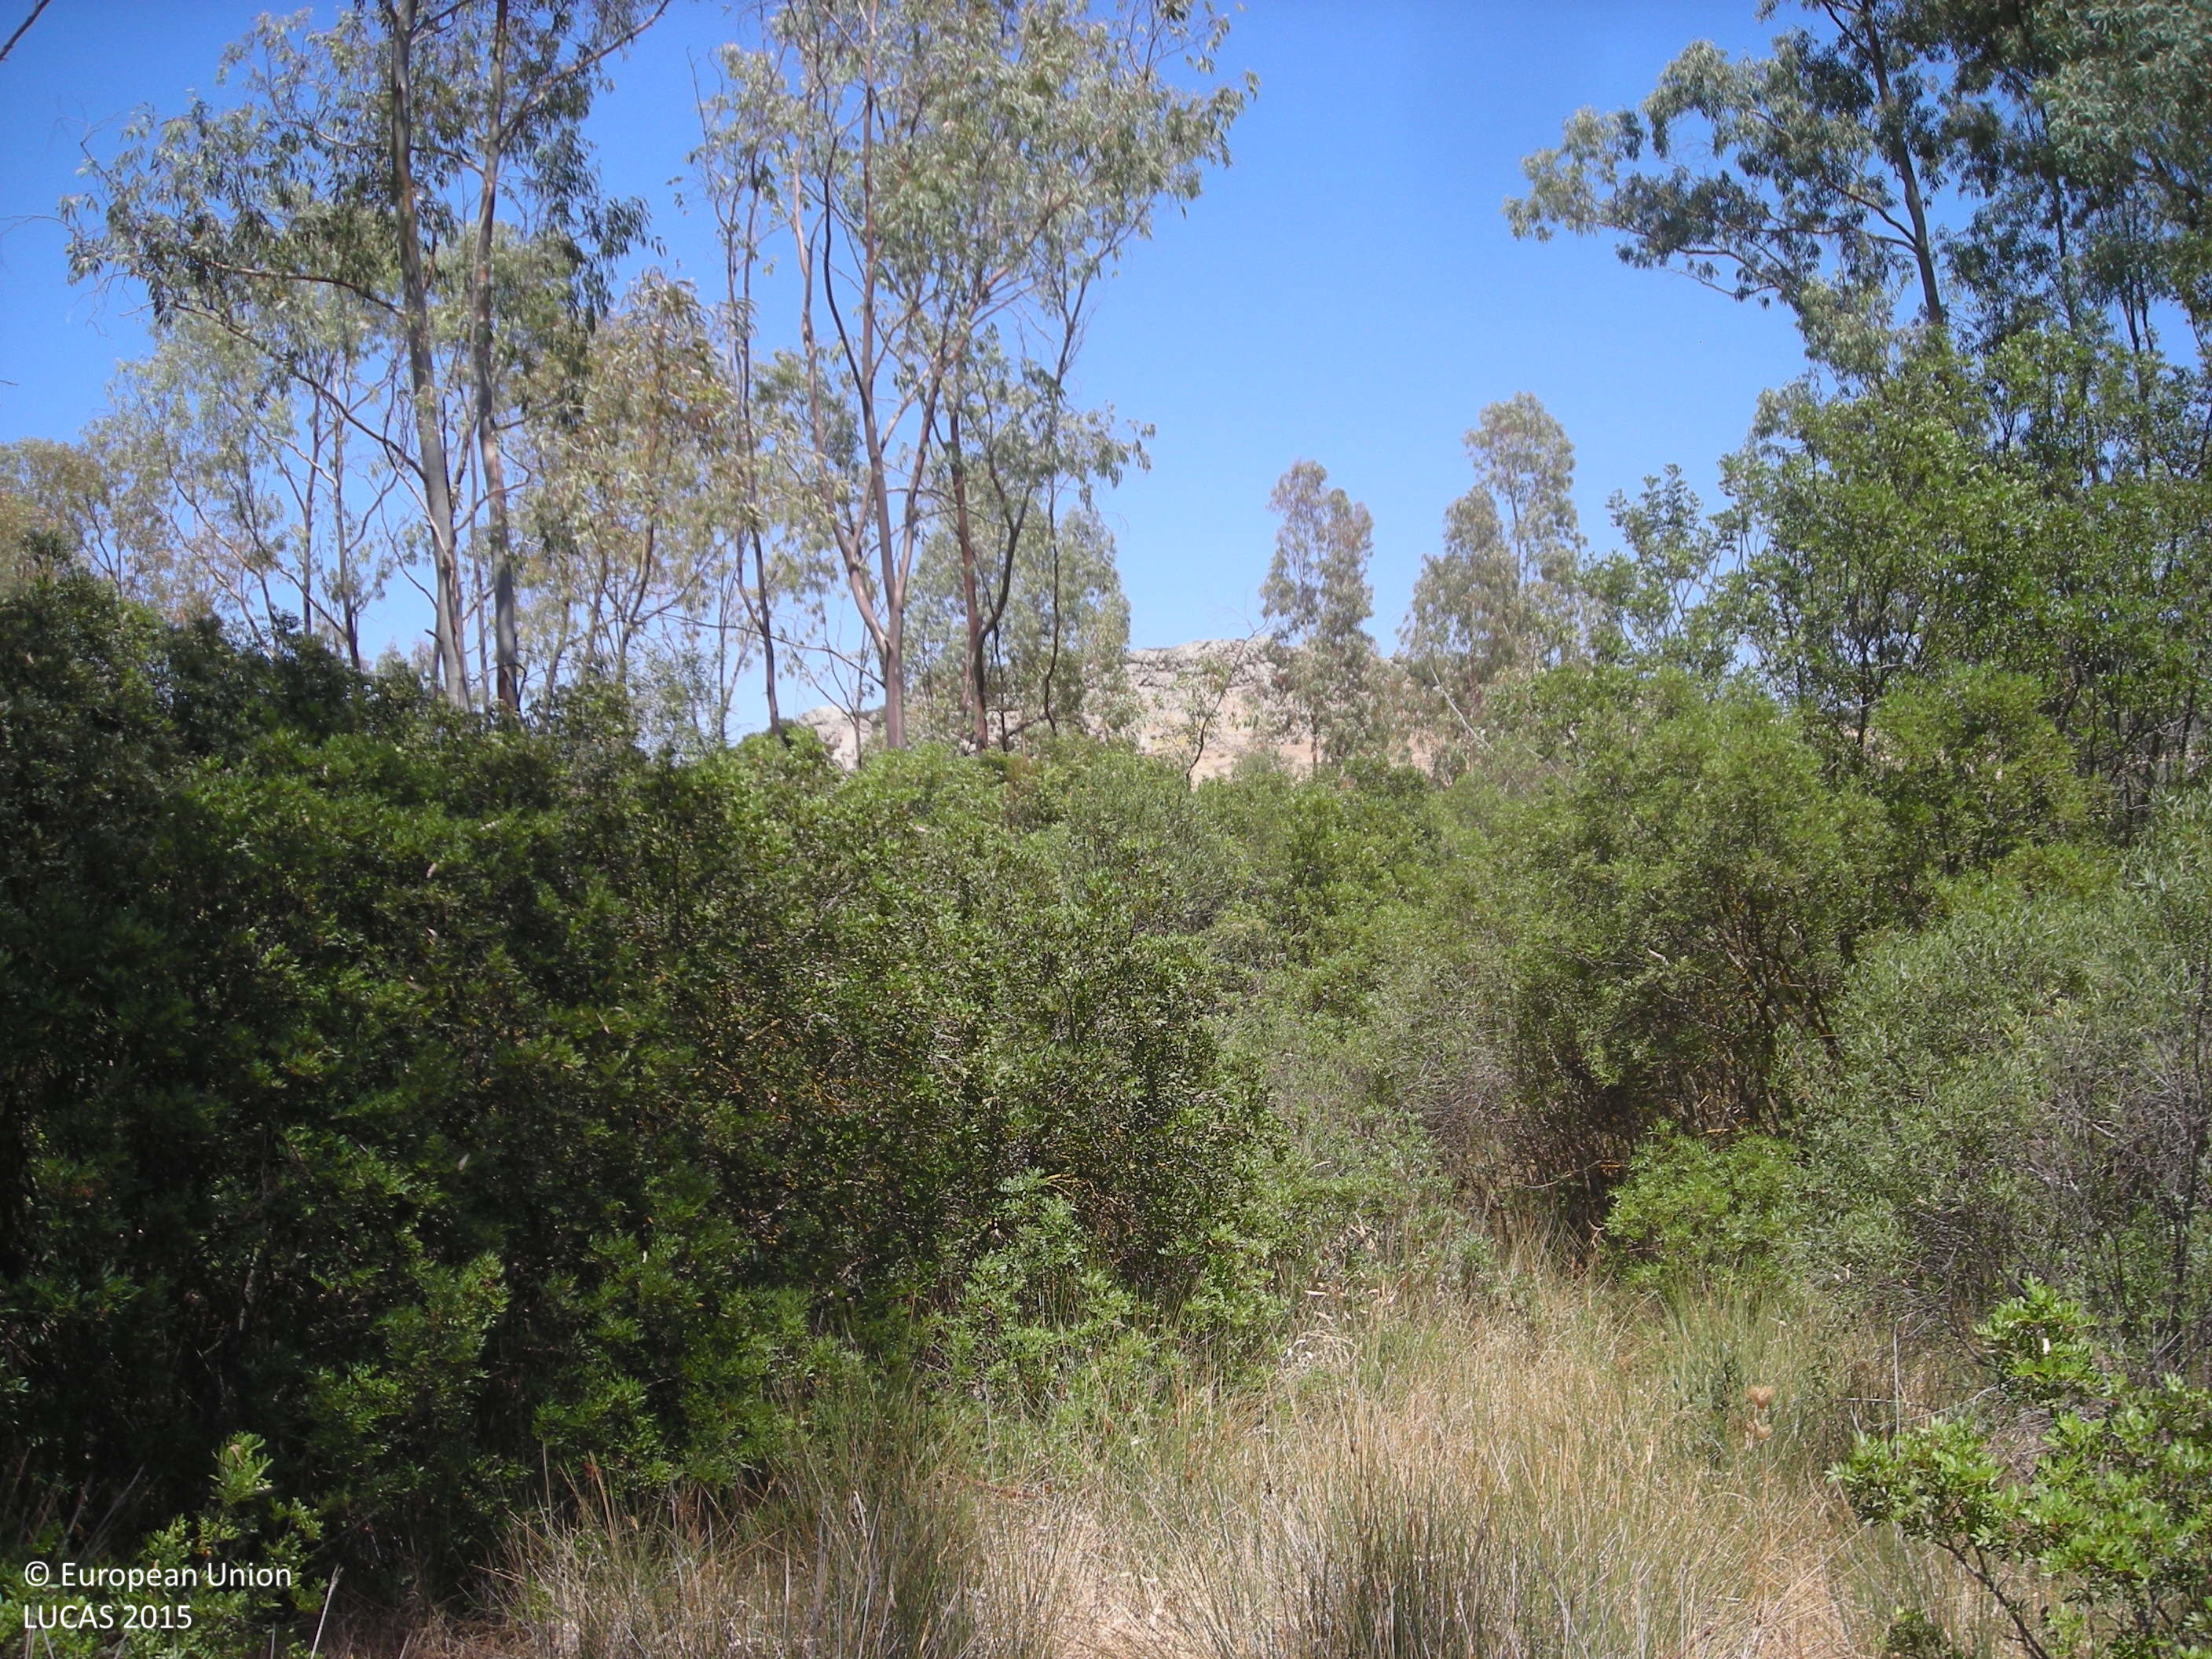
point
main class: Shrubland
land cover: Shrubland without tree cover
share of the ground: > 75 %
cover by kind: shrubs 100 %
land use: Semi-natural and natural areas not in use
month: July
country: ES
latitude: 38.7574
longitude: -5.7986
